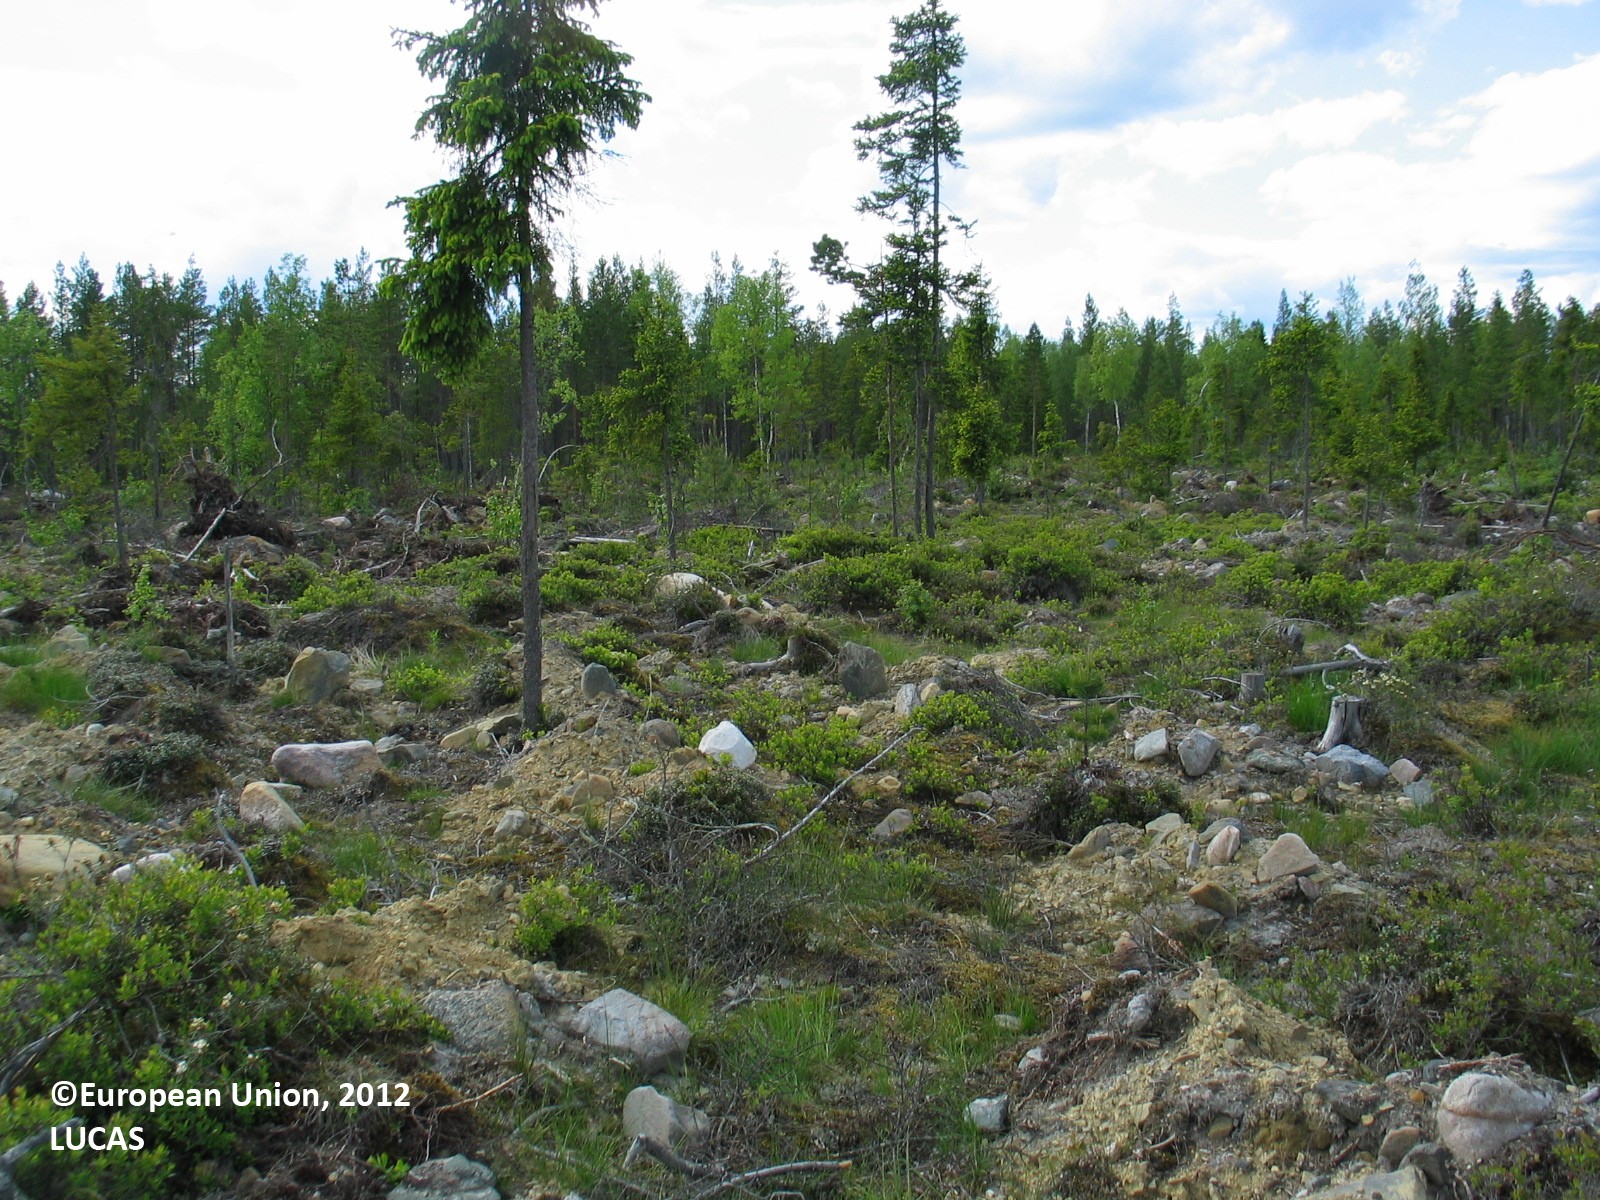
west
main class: Shrubland
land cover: Shrubland without tree cover
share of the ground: 25 - 50 %
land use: Forestry
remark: Clear cut
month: June
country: FI
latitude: 64.8955
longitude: 26.5236
